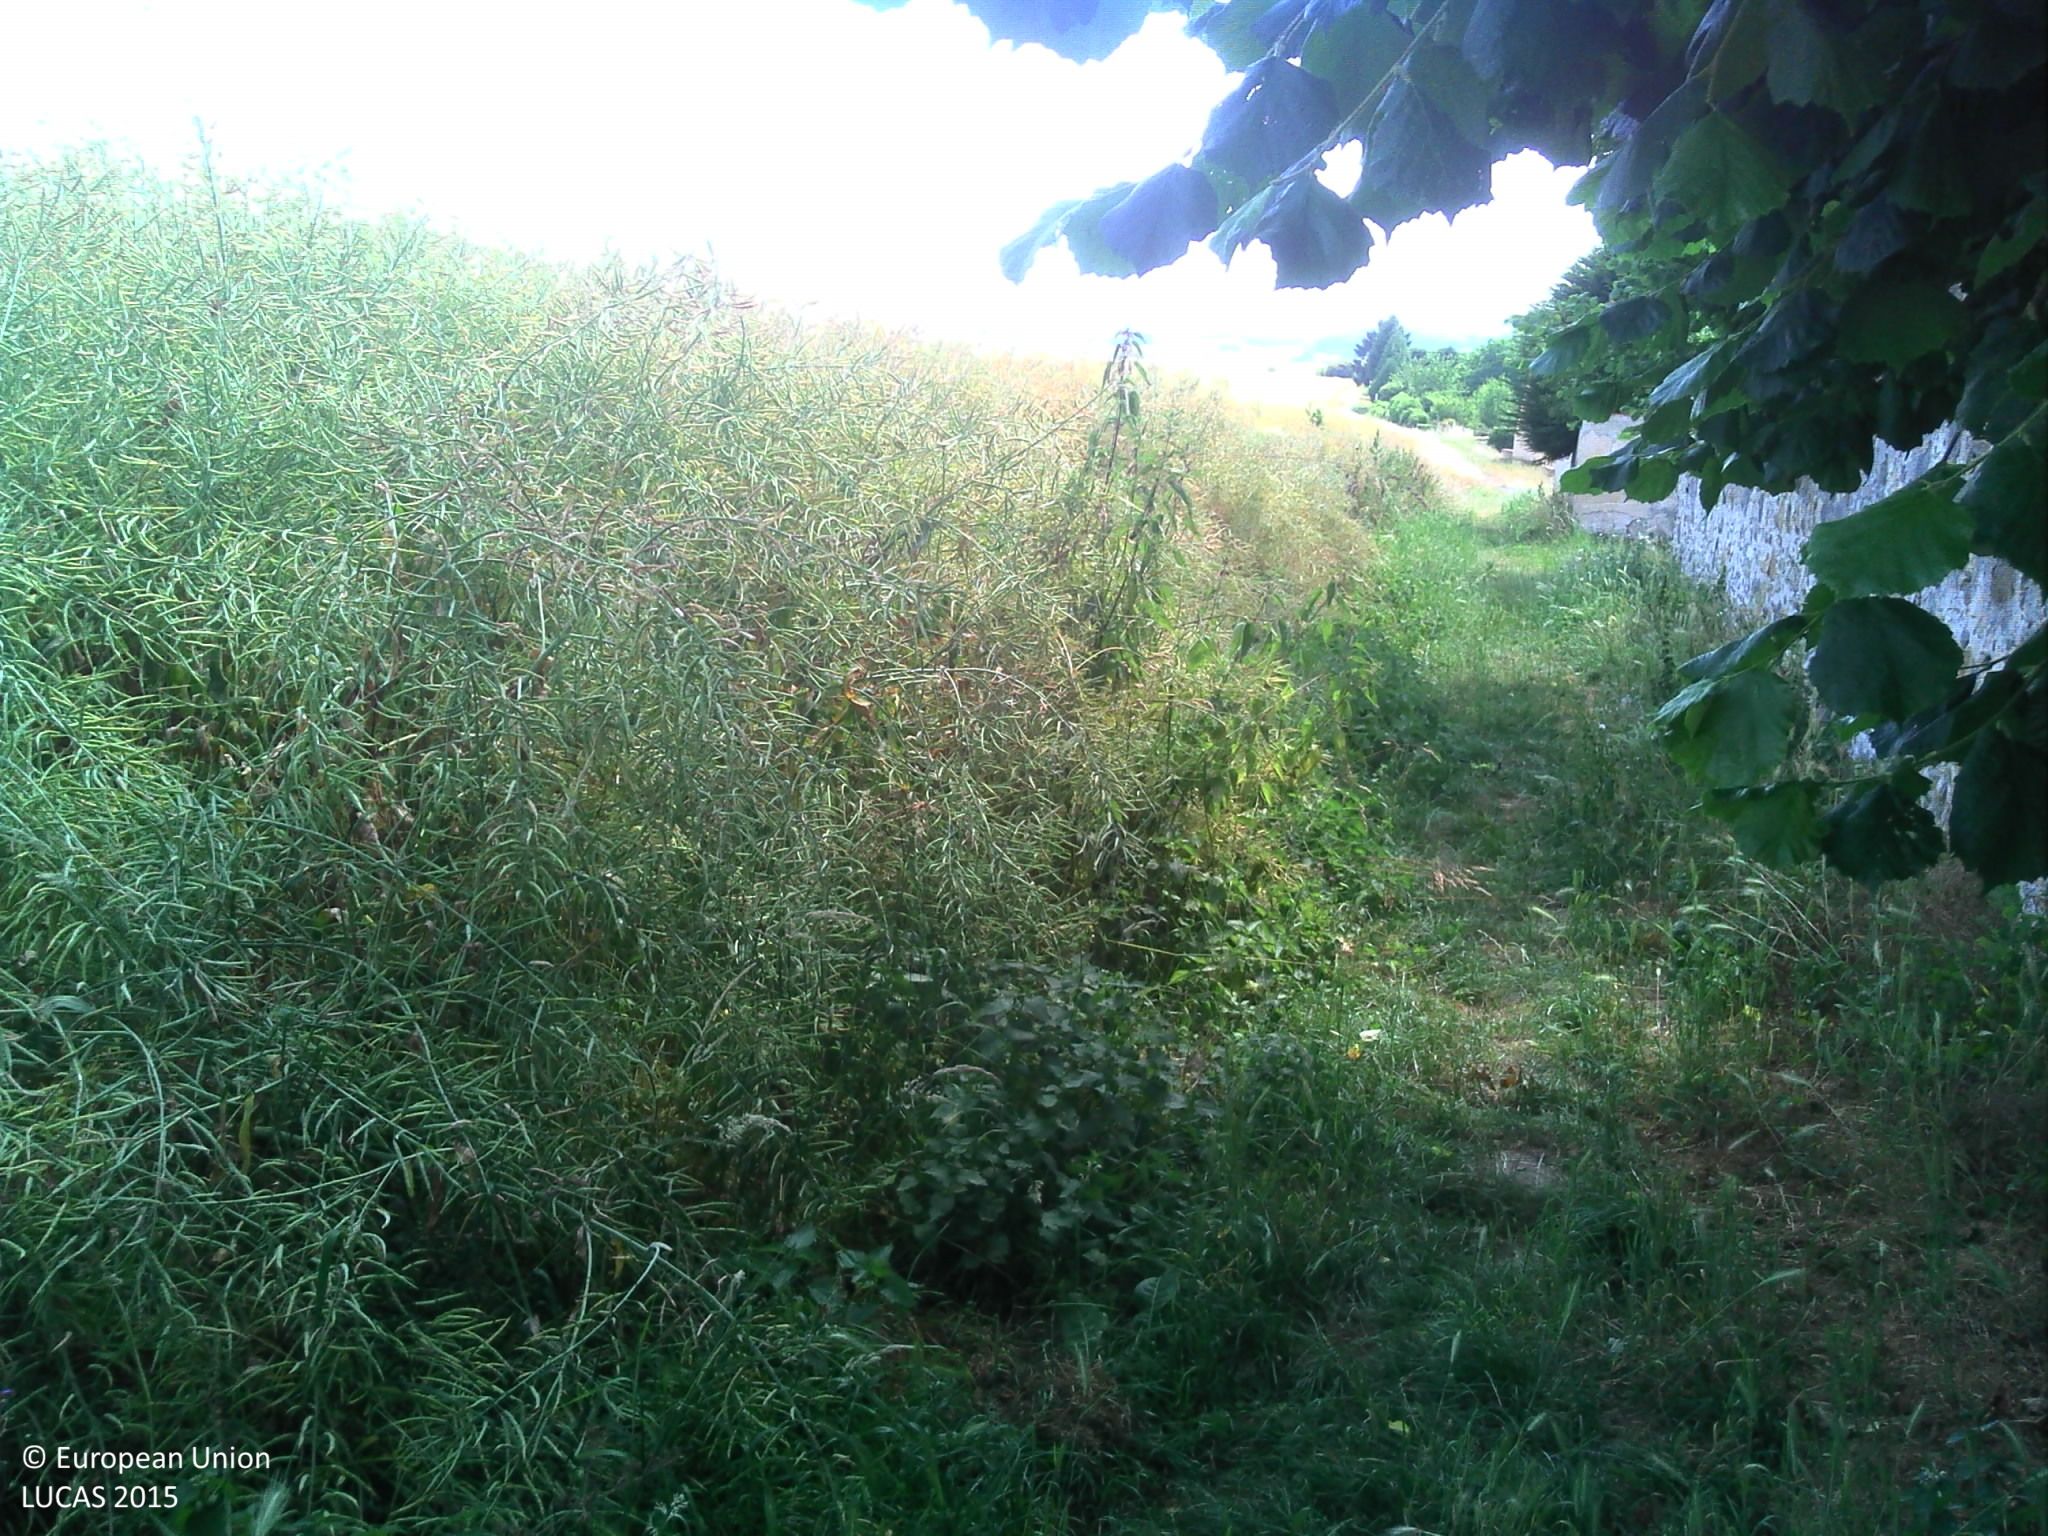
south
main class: Cropland
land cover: Rape and turnip rape
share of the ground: > 75 %
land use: Agriculture (excluding fallow land and kitchen gardens)
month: July
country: FR
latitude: 49.1220
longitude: 3.3193
